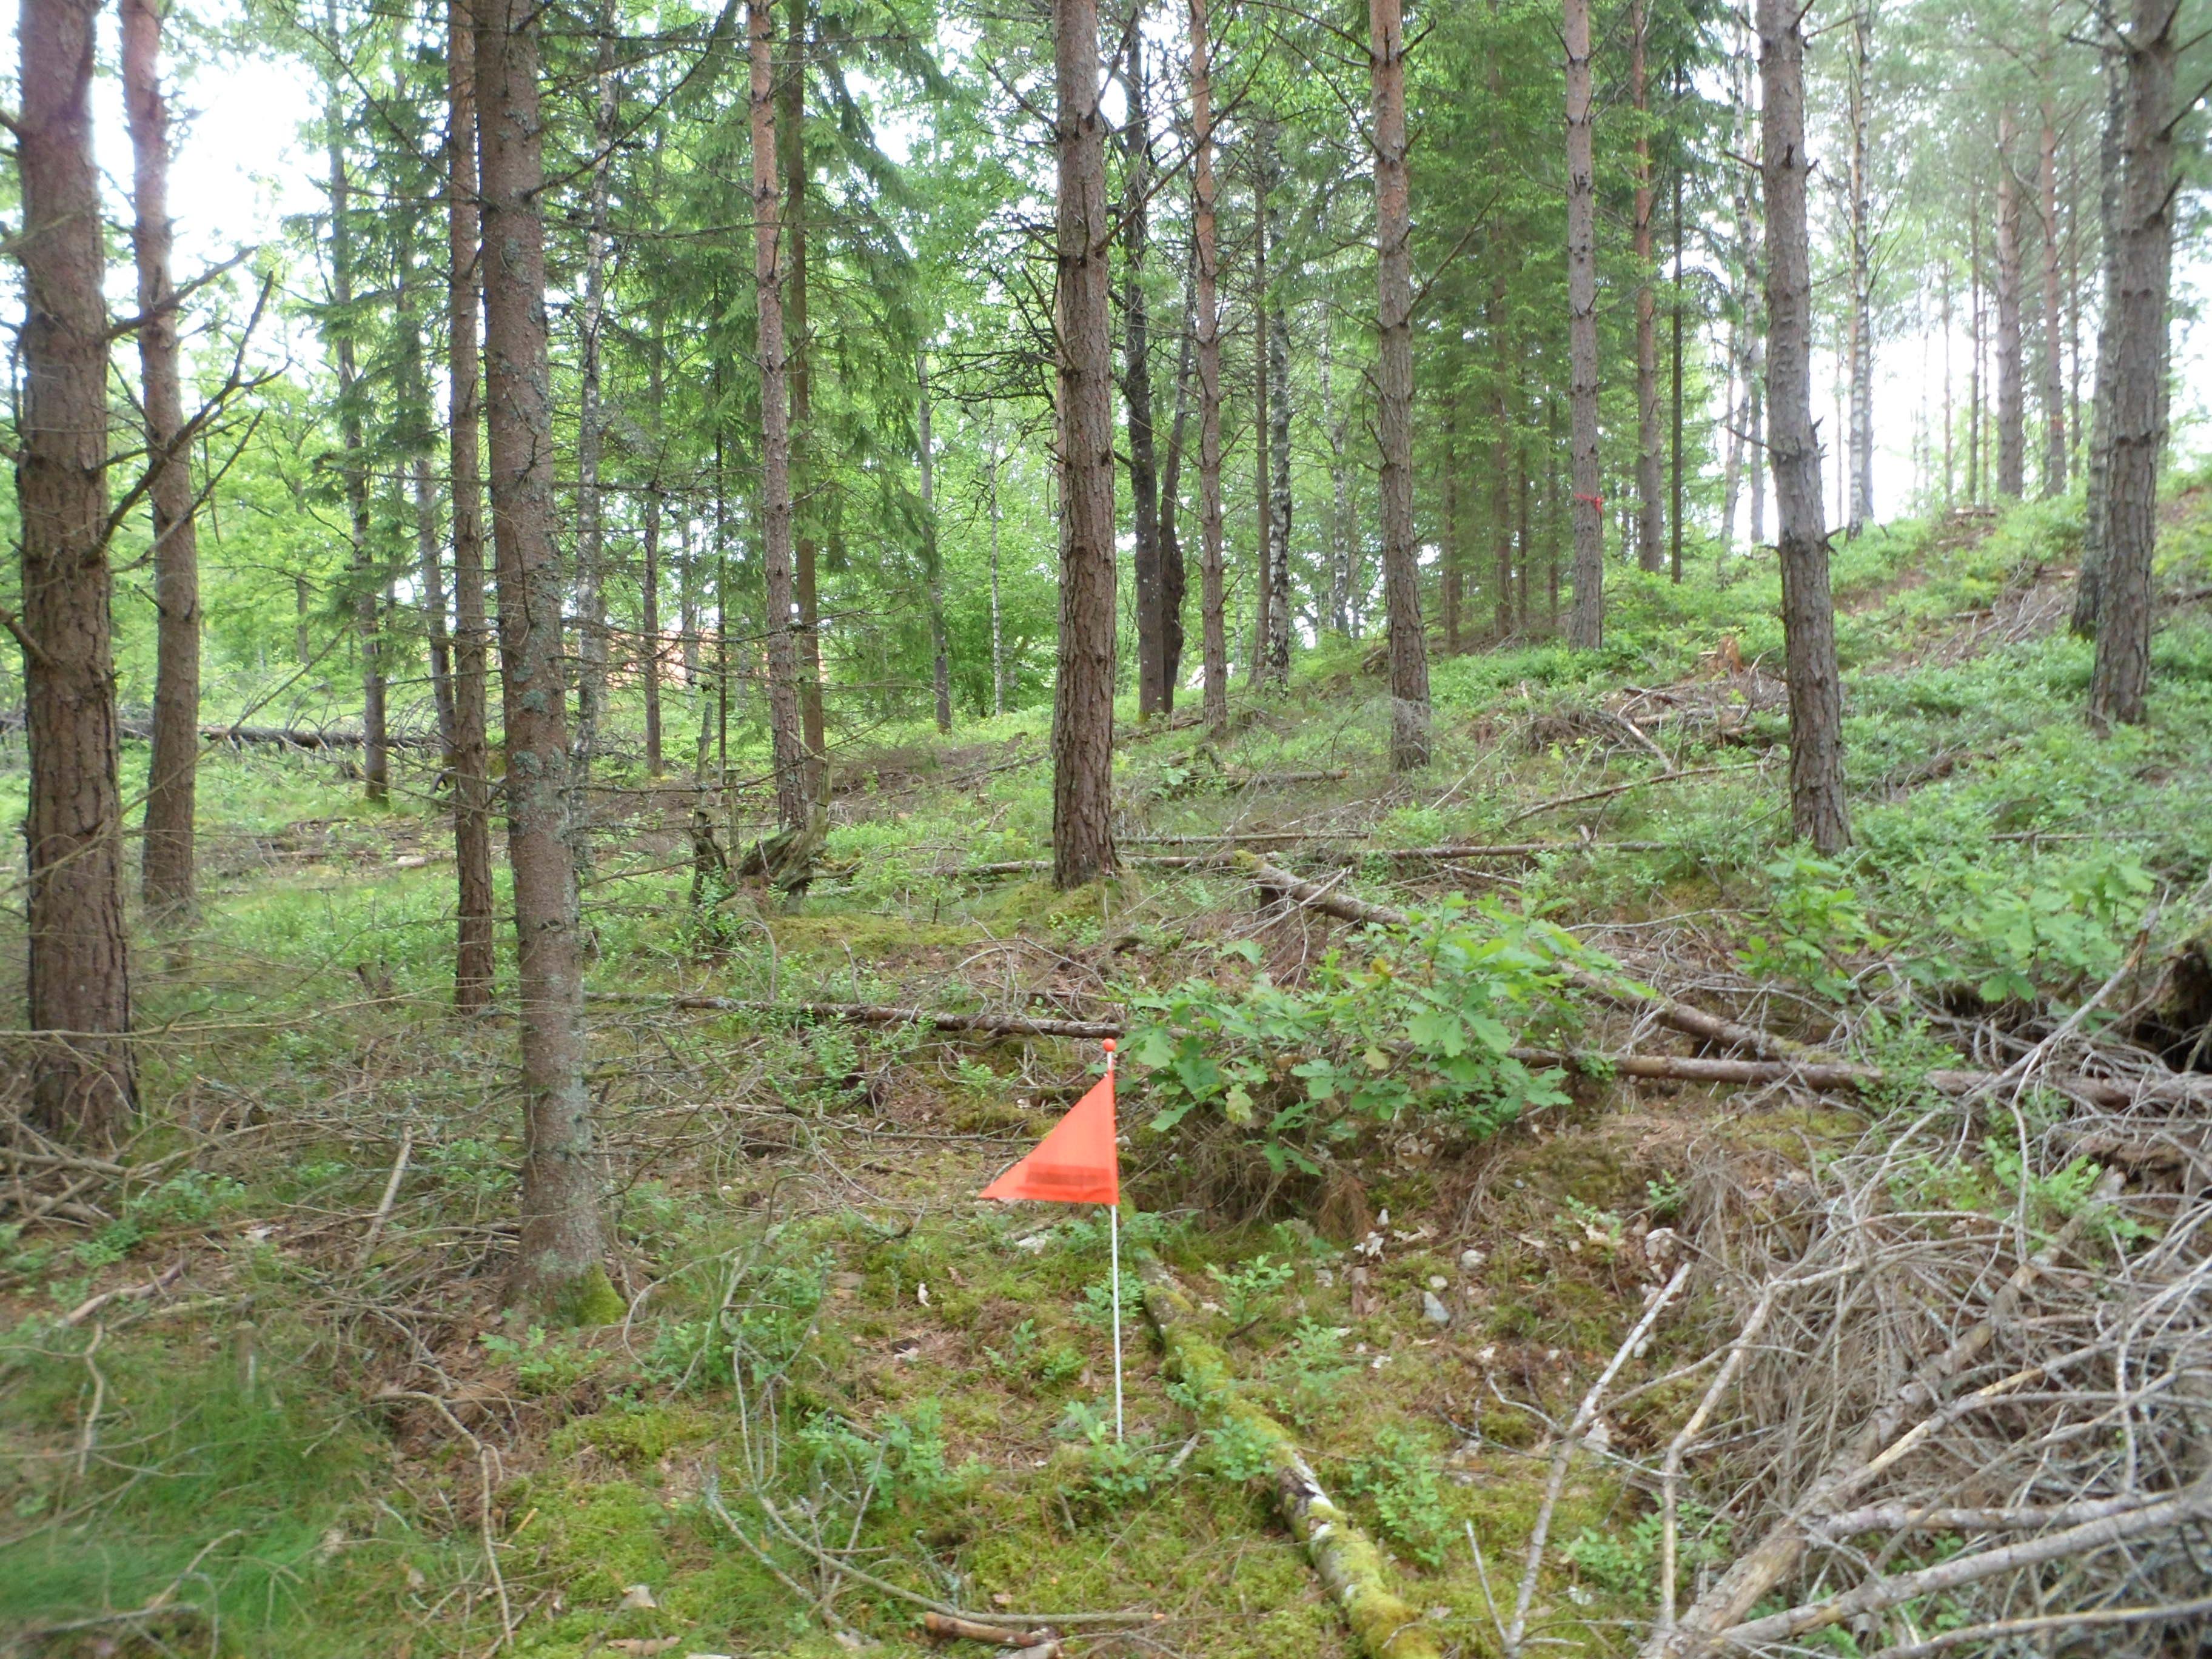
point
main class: Woodland
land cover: Pine dominated coniferous woodland
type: boreal forest
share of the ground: 50 - 75 %
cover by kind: coniferous forest trees 65 %, broadleaved forest trees 10 %, shrubs 10 %, lichens and mosses 10 %, herbaceous plants 5 %
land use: Forestry
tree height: > 5 m
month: June
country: SE
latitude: 56.9200
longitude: 14.4814
